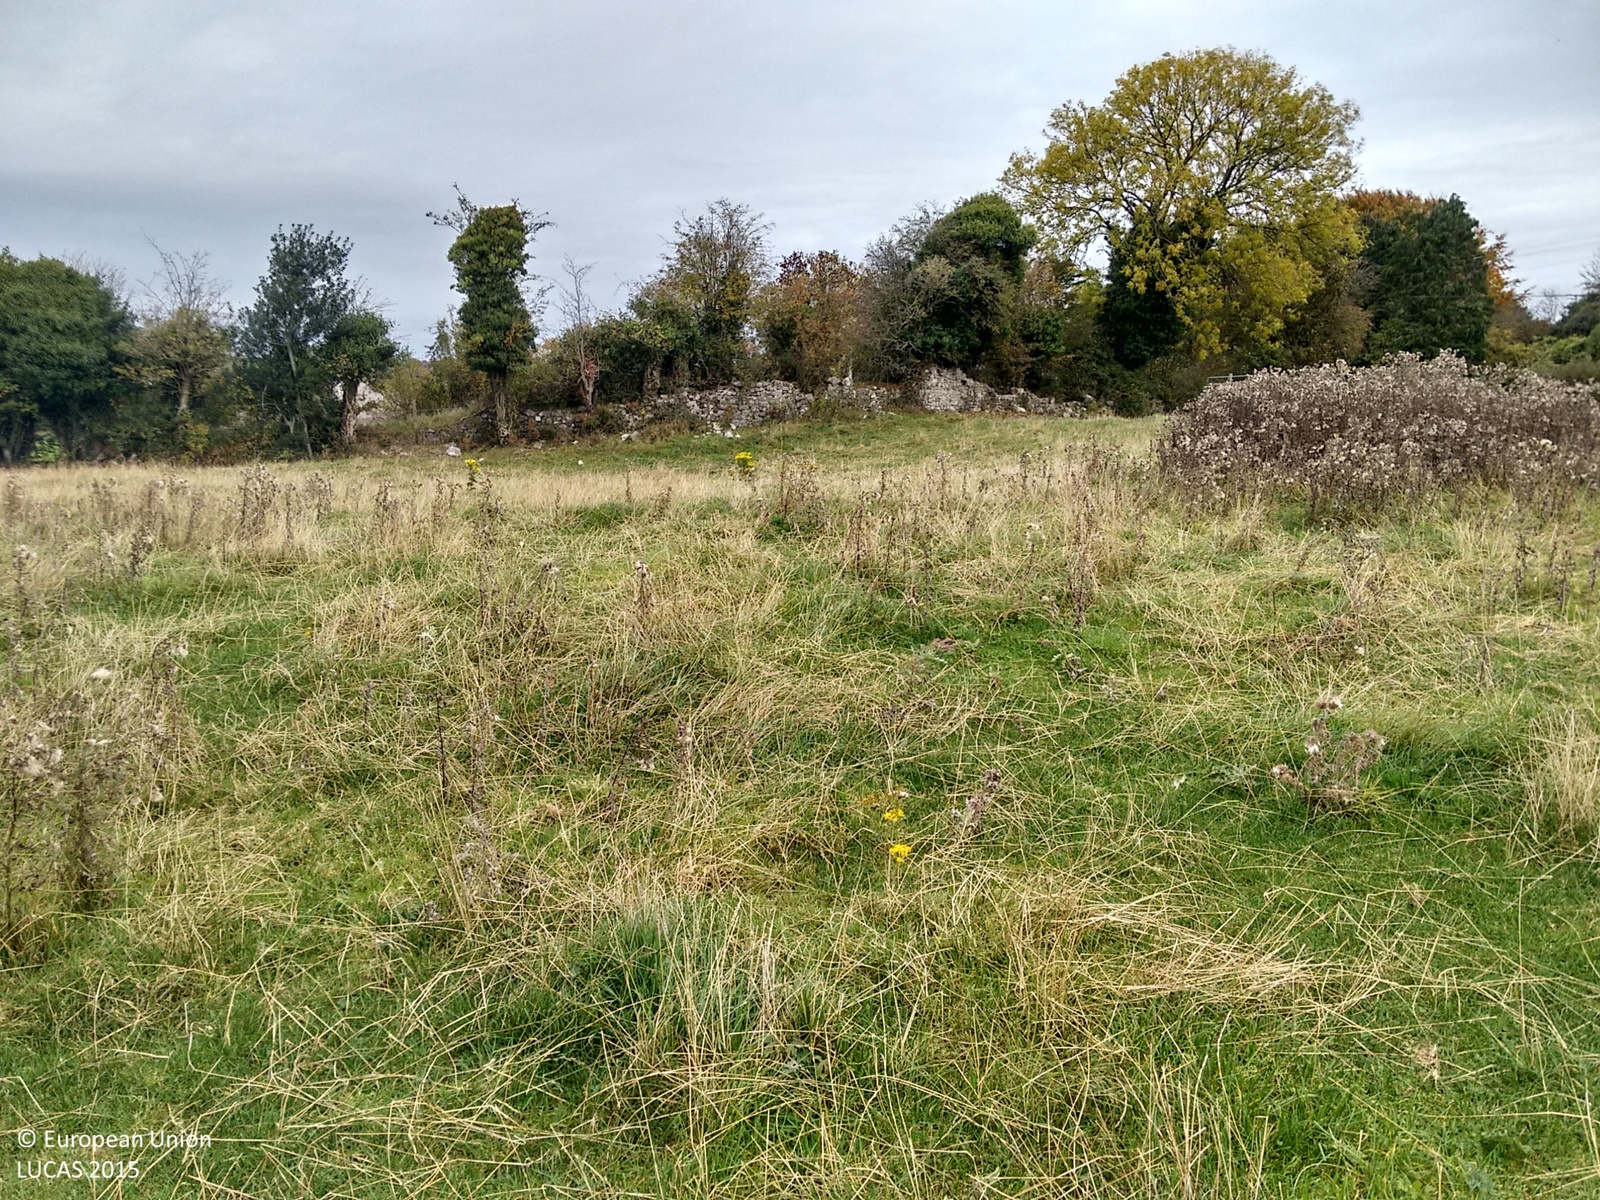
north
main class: Grassland
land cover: Grassland without tree/shrub cover
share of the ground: > 75 %
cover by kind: herbaceous plants 100 %
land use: Agriculture (excluding fallow land and kitchen gardens)
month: October
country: IE
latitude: 53.0815
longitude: -7.7995
